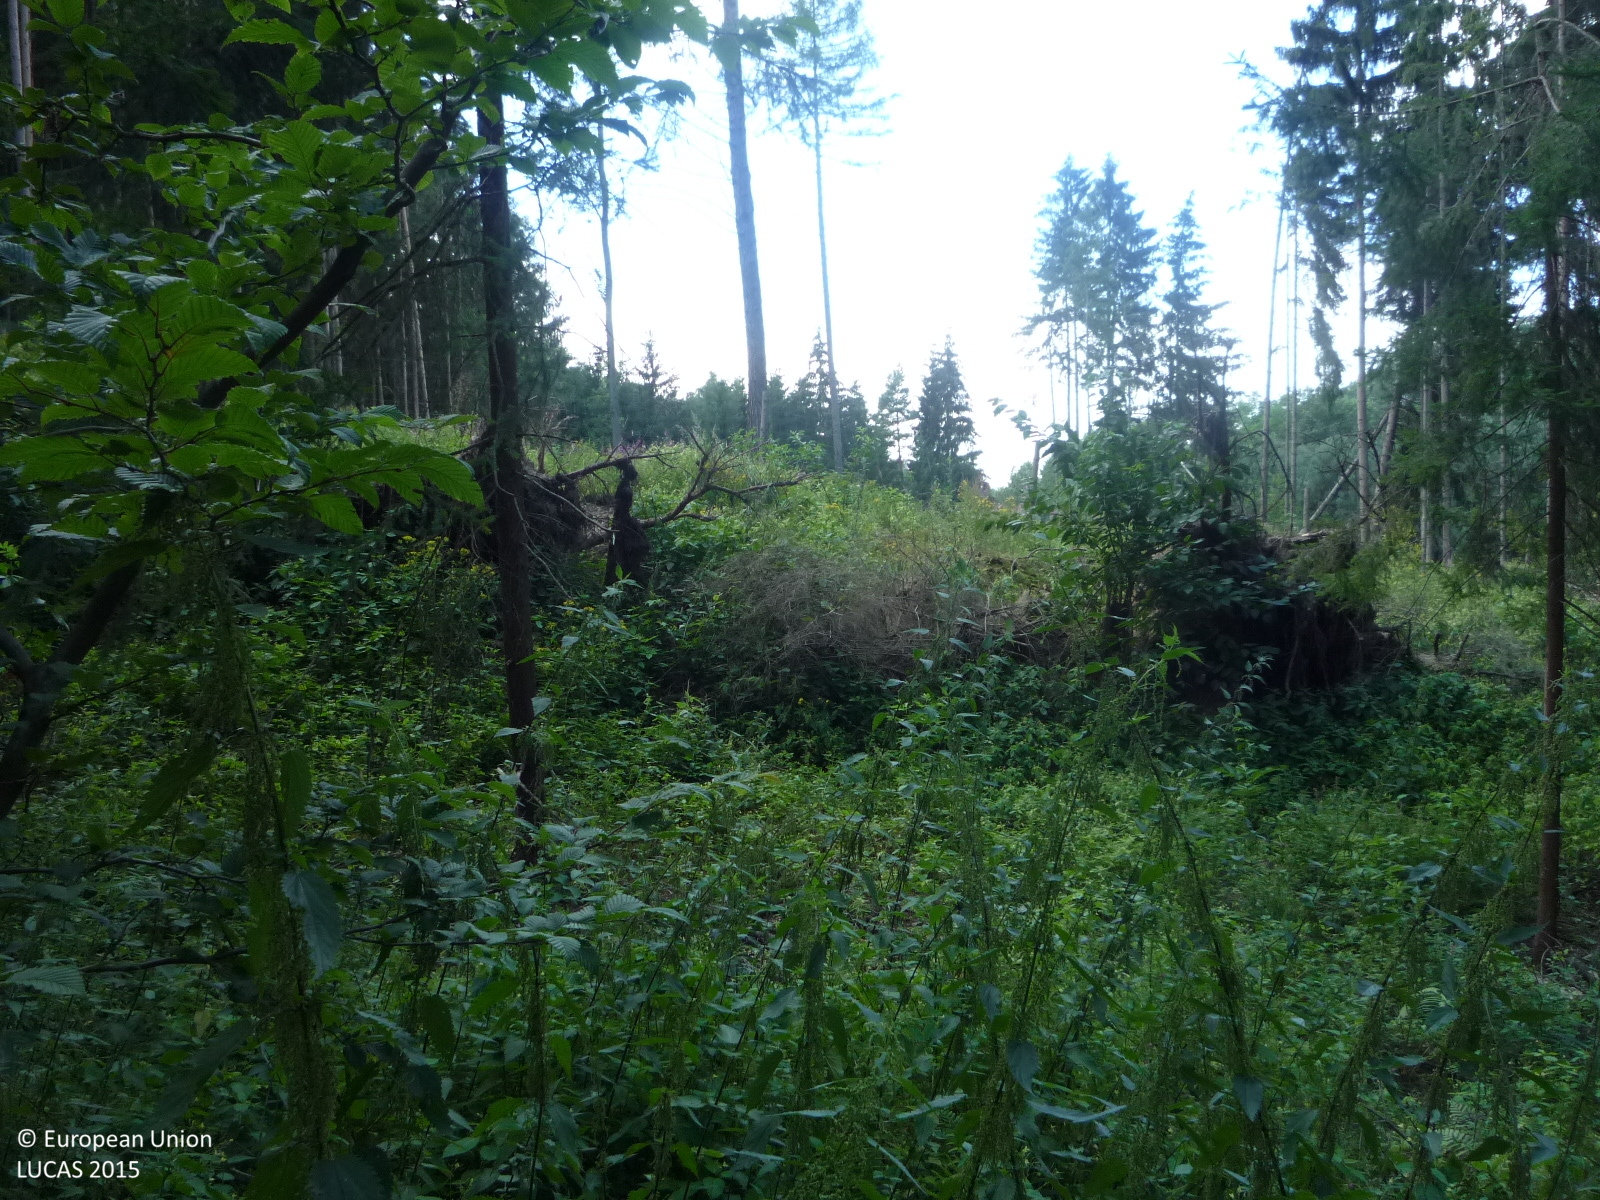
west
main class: Woodland
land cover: Other mixed woodland
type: hemiboreal forest and nemoral coniferous forest and mixed broadleaved-coniferous forest
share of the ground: > 75 %
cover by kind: coniferous forest trees 50 %, broadleaved forest trees 30 %, herbaceous plants 20 %
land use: Forestry
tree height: > 5 m
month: July
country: CZ
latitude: 50.5456
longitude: 14.5035
